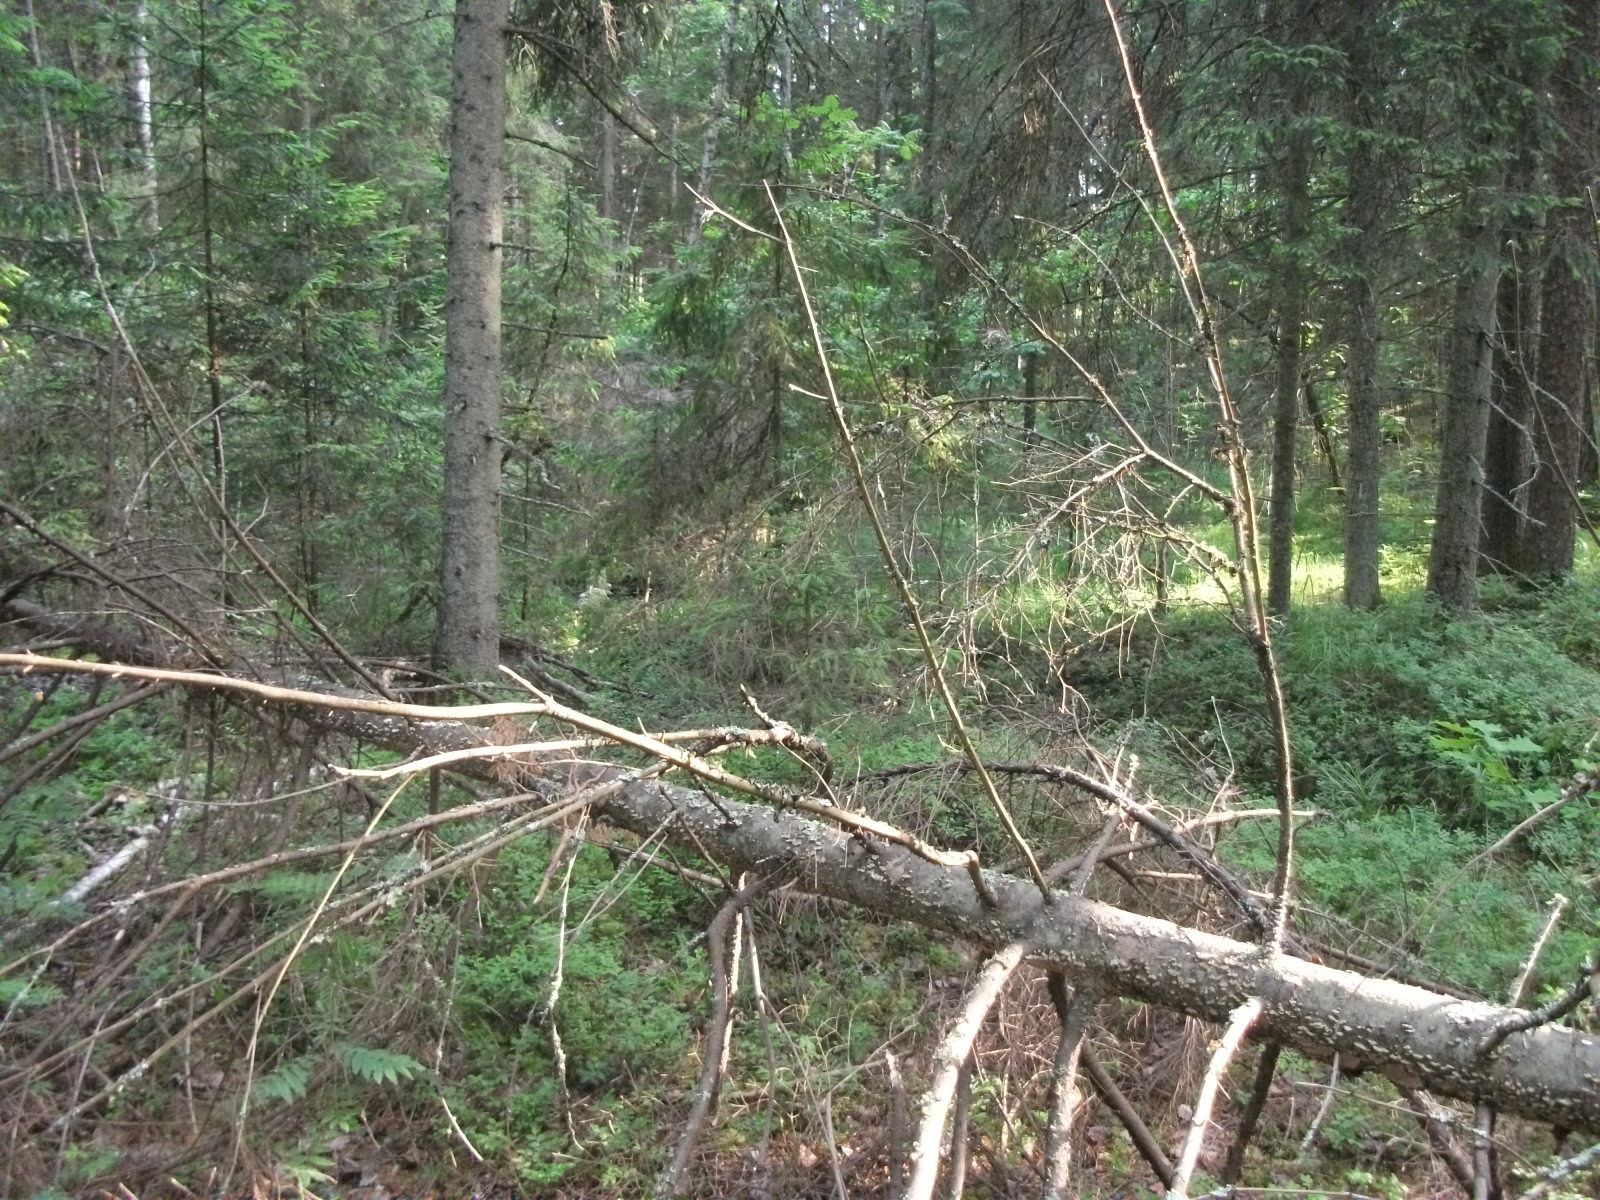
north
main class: Woodland
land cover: Other coniferous woodland
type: hemiboreal forest and nemoral coniferous forest and mixed broadleaved-coniferous forest
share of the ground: > 75 %
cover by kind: coniferous forest trees 85 %, shrubs 10 %, lichens and mosses 5 %
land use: Forestry
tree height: > 5 m
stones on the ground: < 10 %
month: July
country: LV
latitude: 57.1516
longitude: 26.3562
